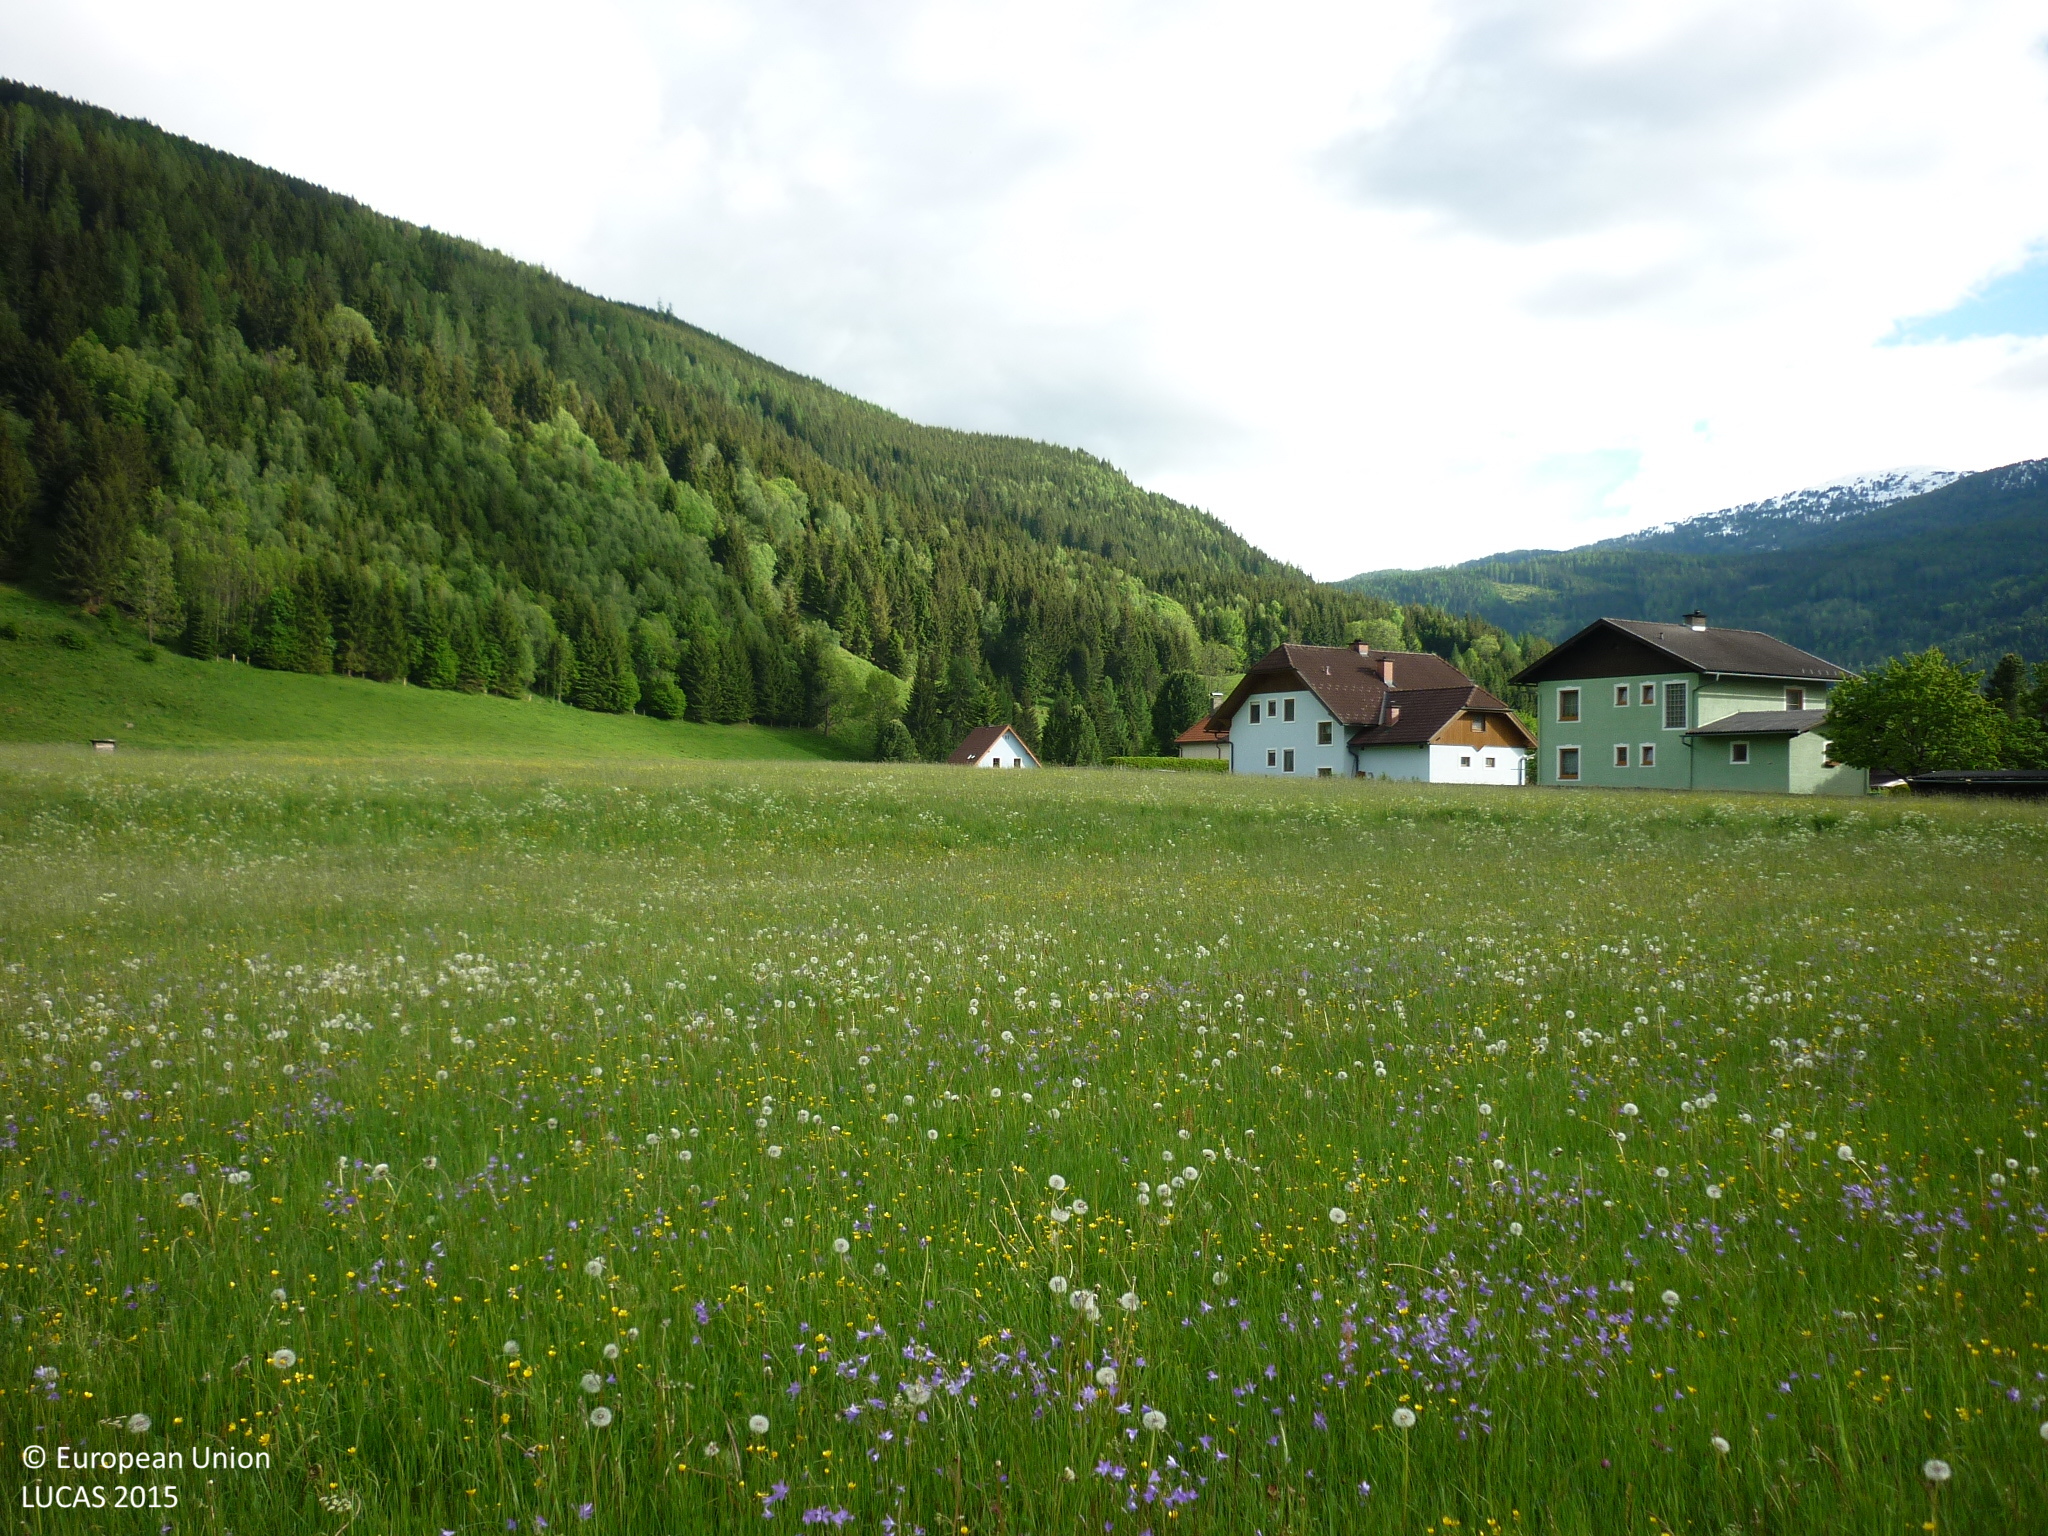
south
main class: Grassland
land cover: Grassland without tree/shrub cover
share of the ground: > 75 %
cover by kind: herbaceous plants 100 %
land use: Agriculture (excluding fallow land and kitchen gardens)
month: May
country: AT
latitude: 47.0881
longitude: 13.9894
